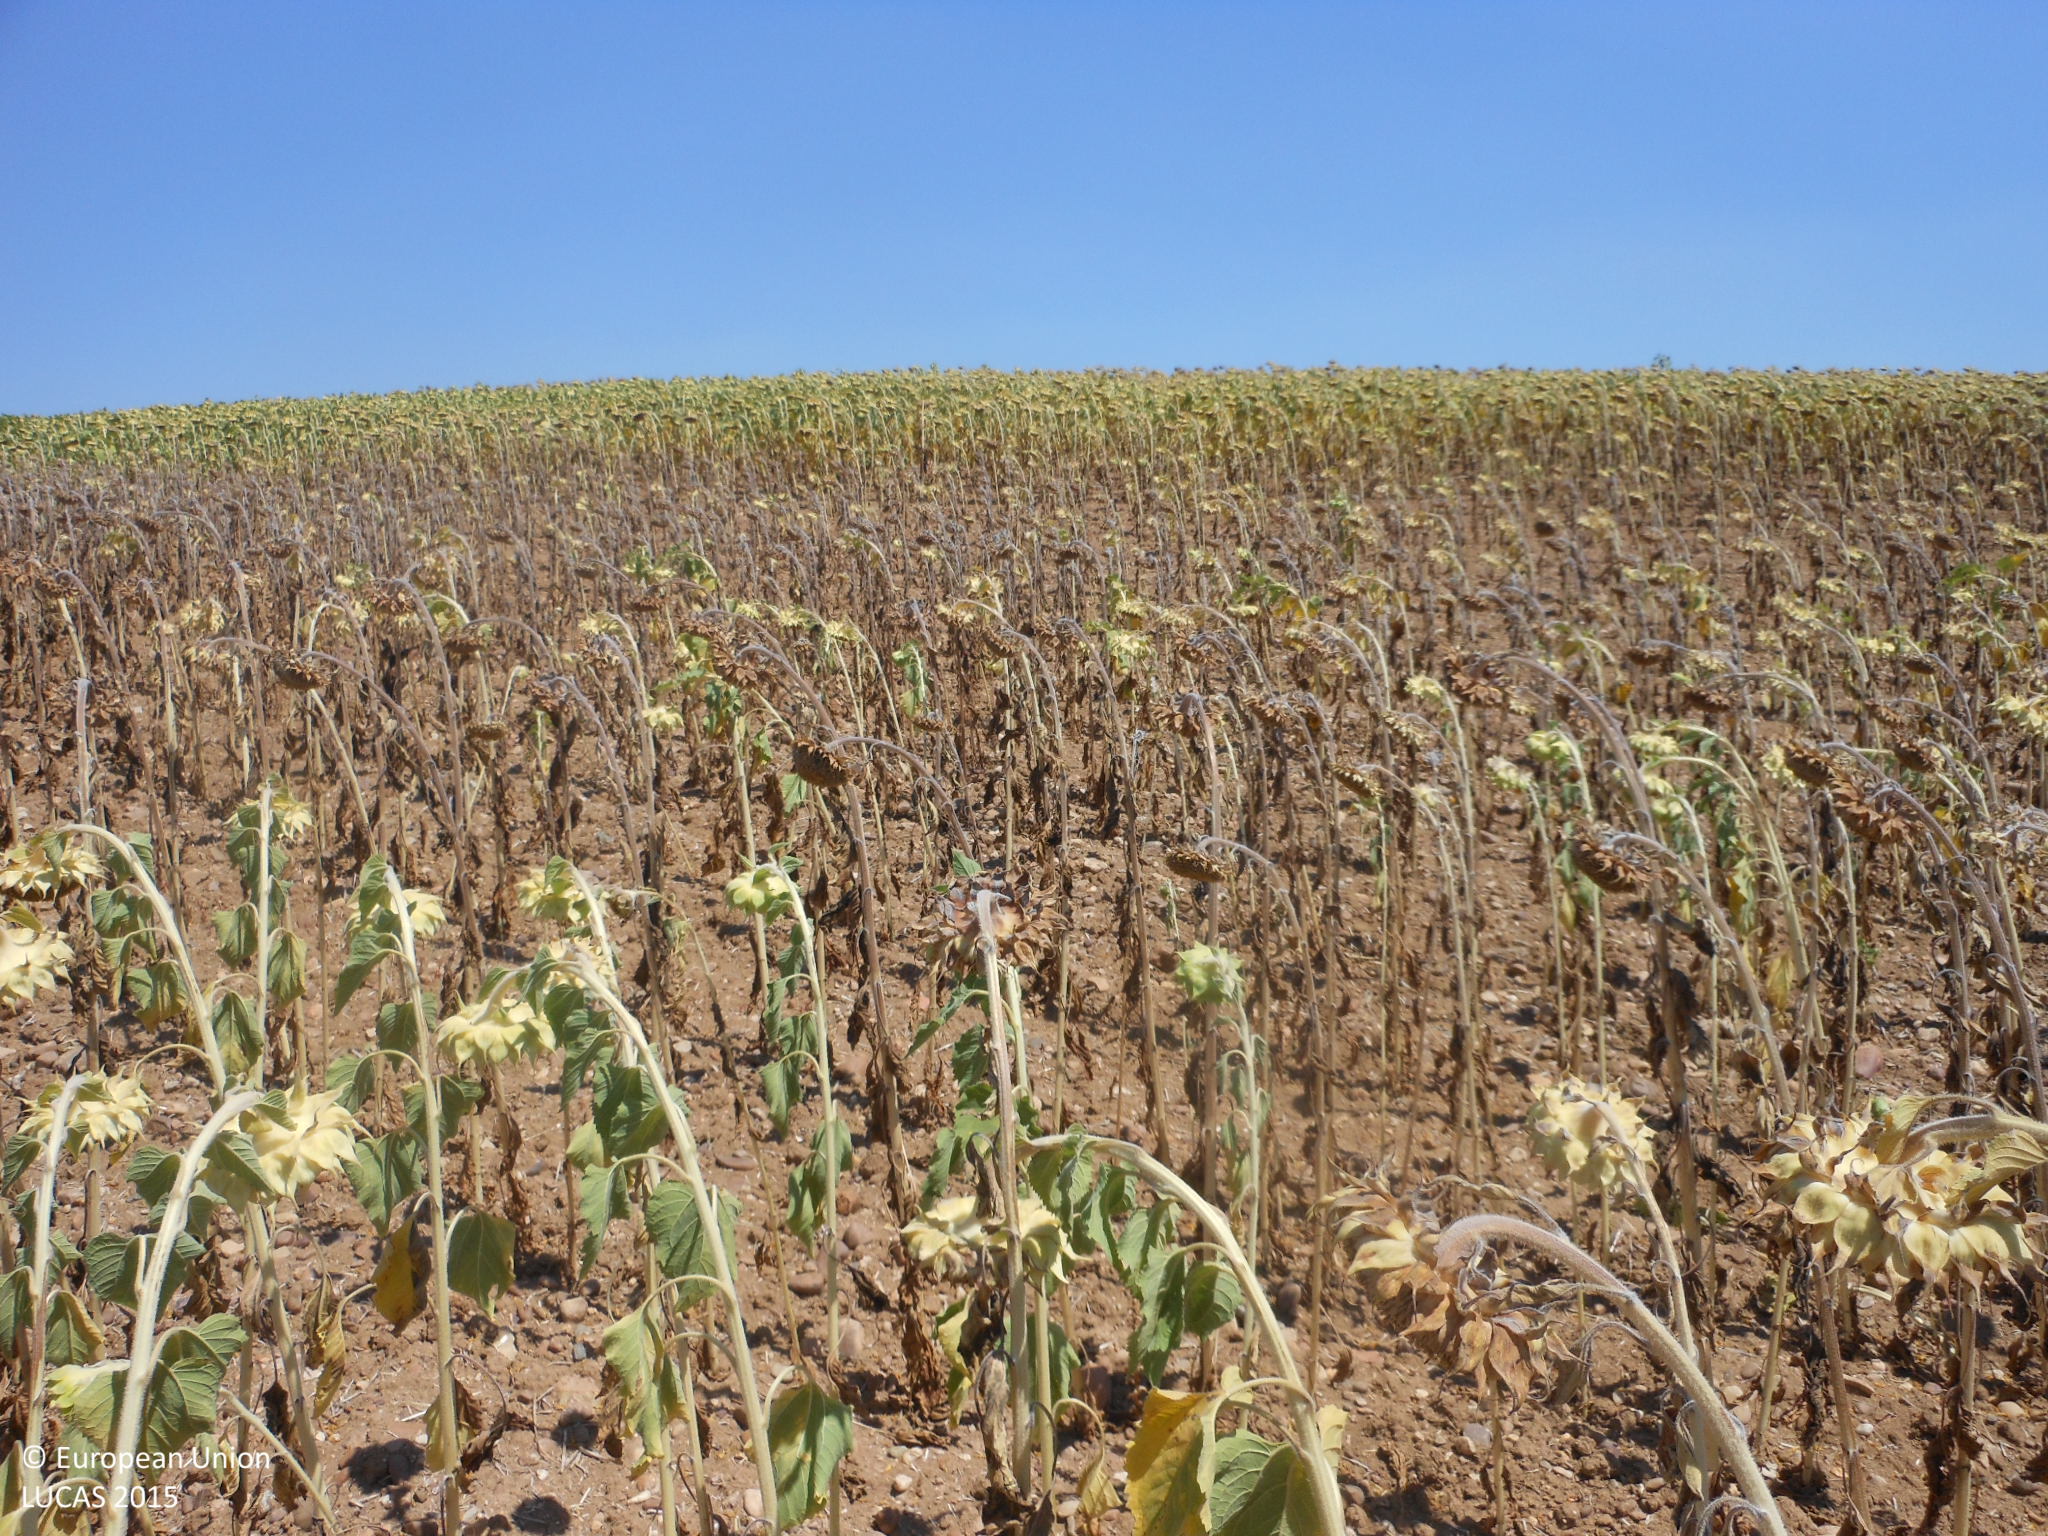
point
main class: Cropland
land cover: Sunflower
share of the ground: > 75 %
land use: Agriculture (excluding fallow land and kitchen gardens)
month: June
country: ES
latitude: 37.5489
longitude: -5.5377
